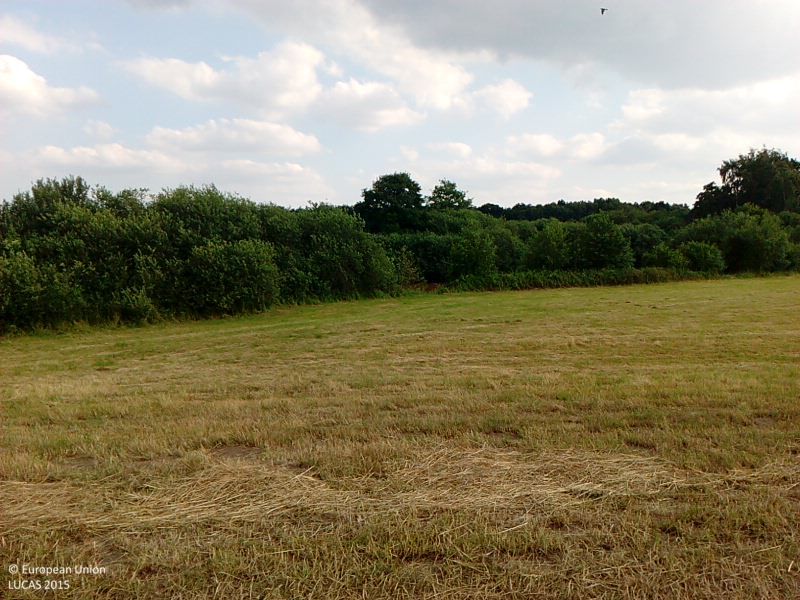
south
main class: Grassland
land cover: Grassland without tree/shrub cover
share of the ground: > 75 %
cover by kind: herbaceous plants 100 %
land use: Agriculture (excluding fallow land and kitchen gardens)
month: July
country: DE
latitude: 52.6730
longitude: 7.4123
